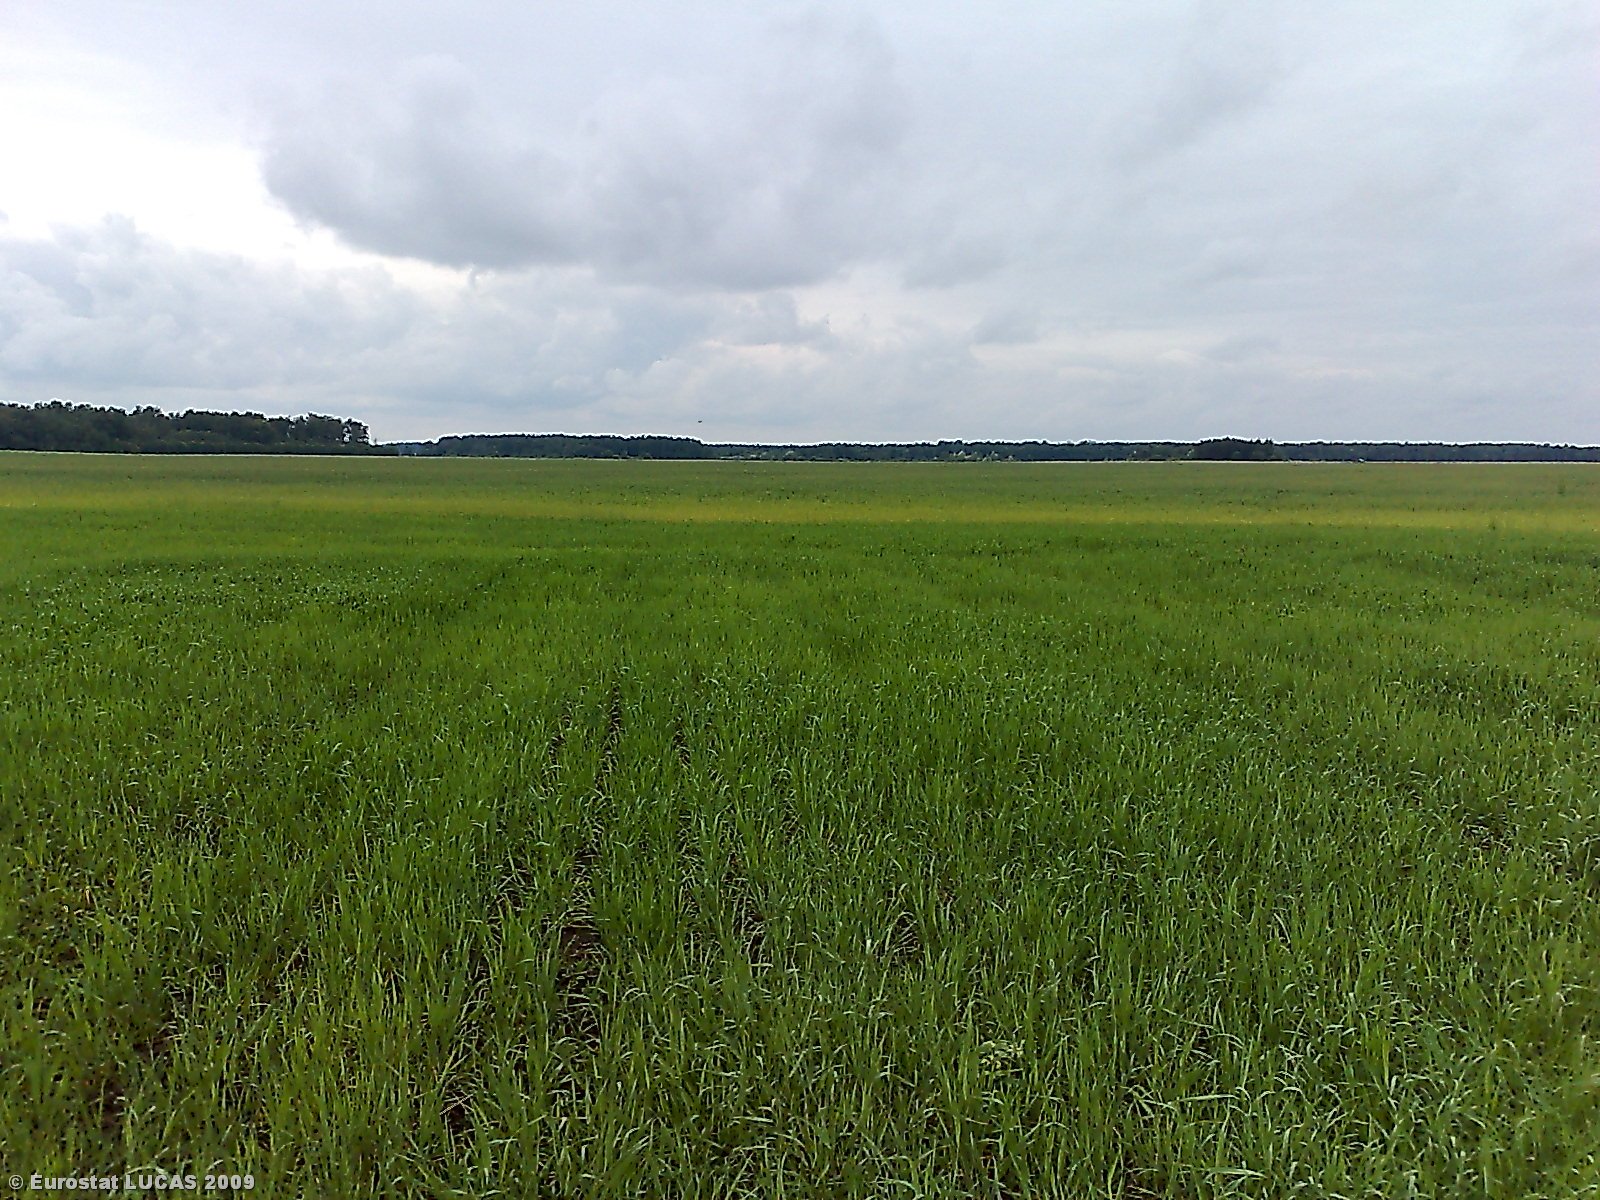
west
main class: Cropland
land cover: Barley
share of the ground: > 75 %
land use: Agriculture (excluding fallow land and kitchen gardens)
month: June
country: LT
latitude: 55.9695
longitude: 23.9454
